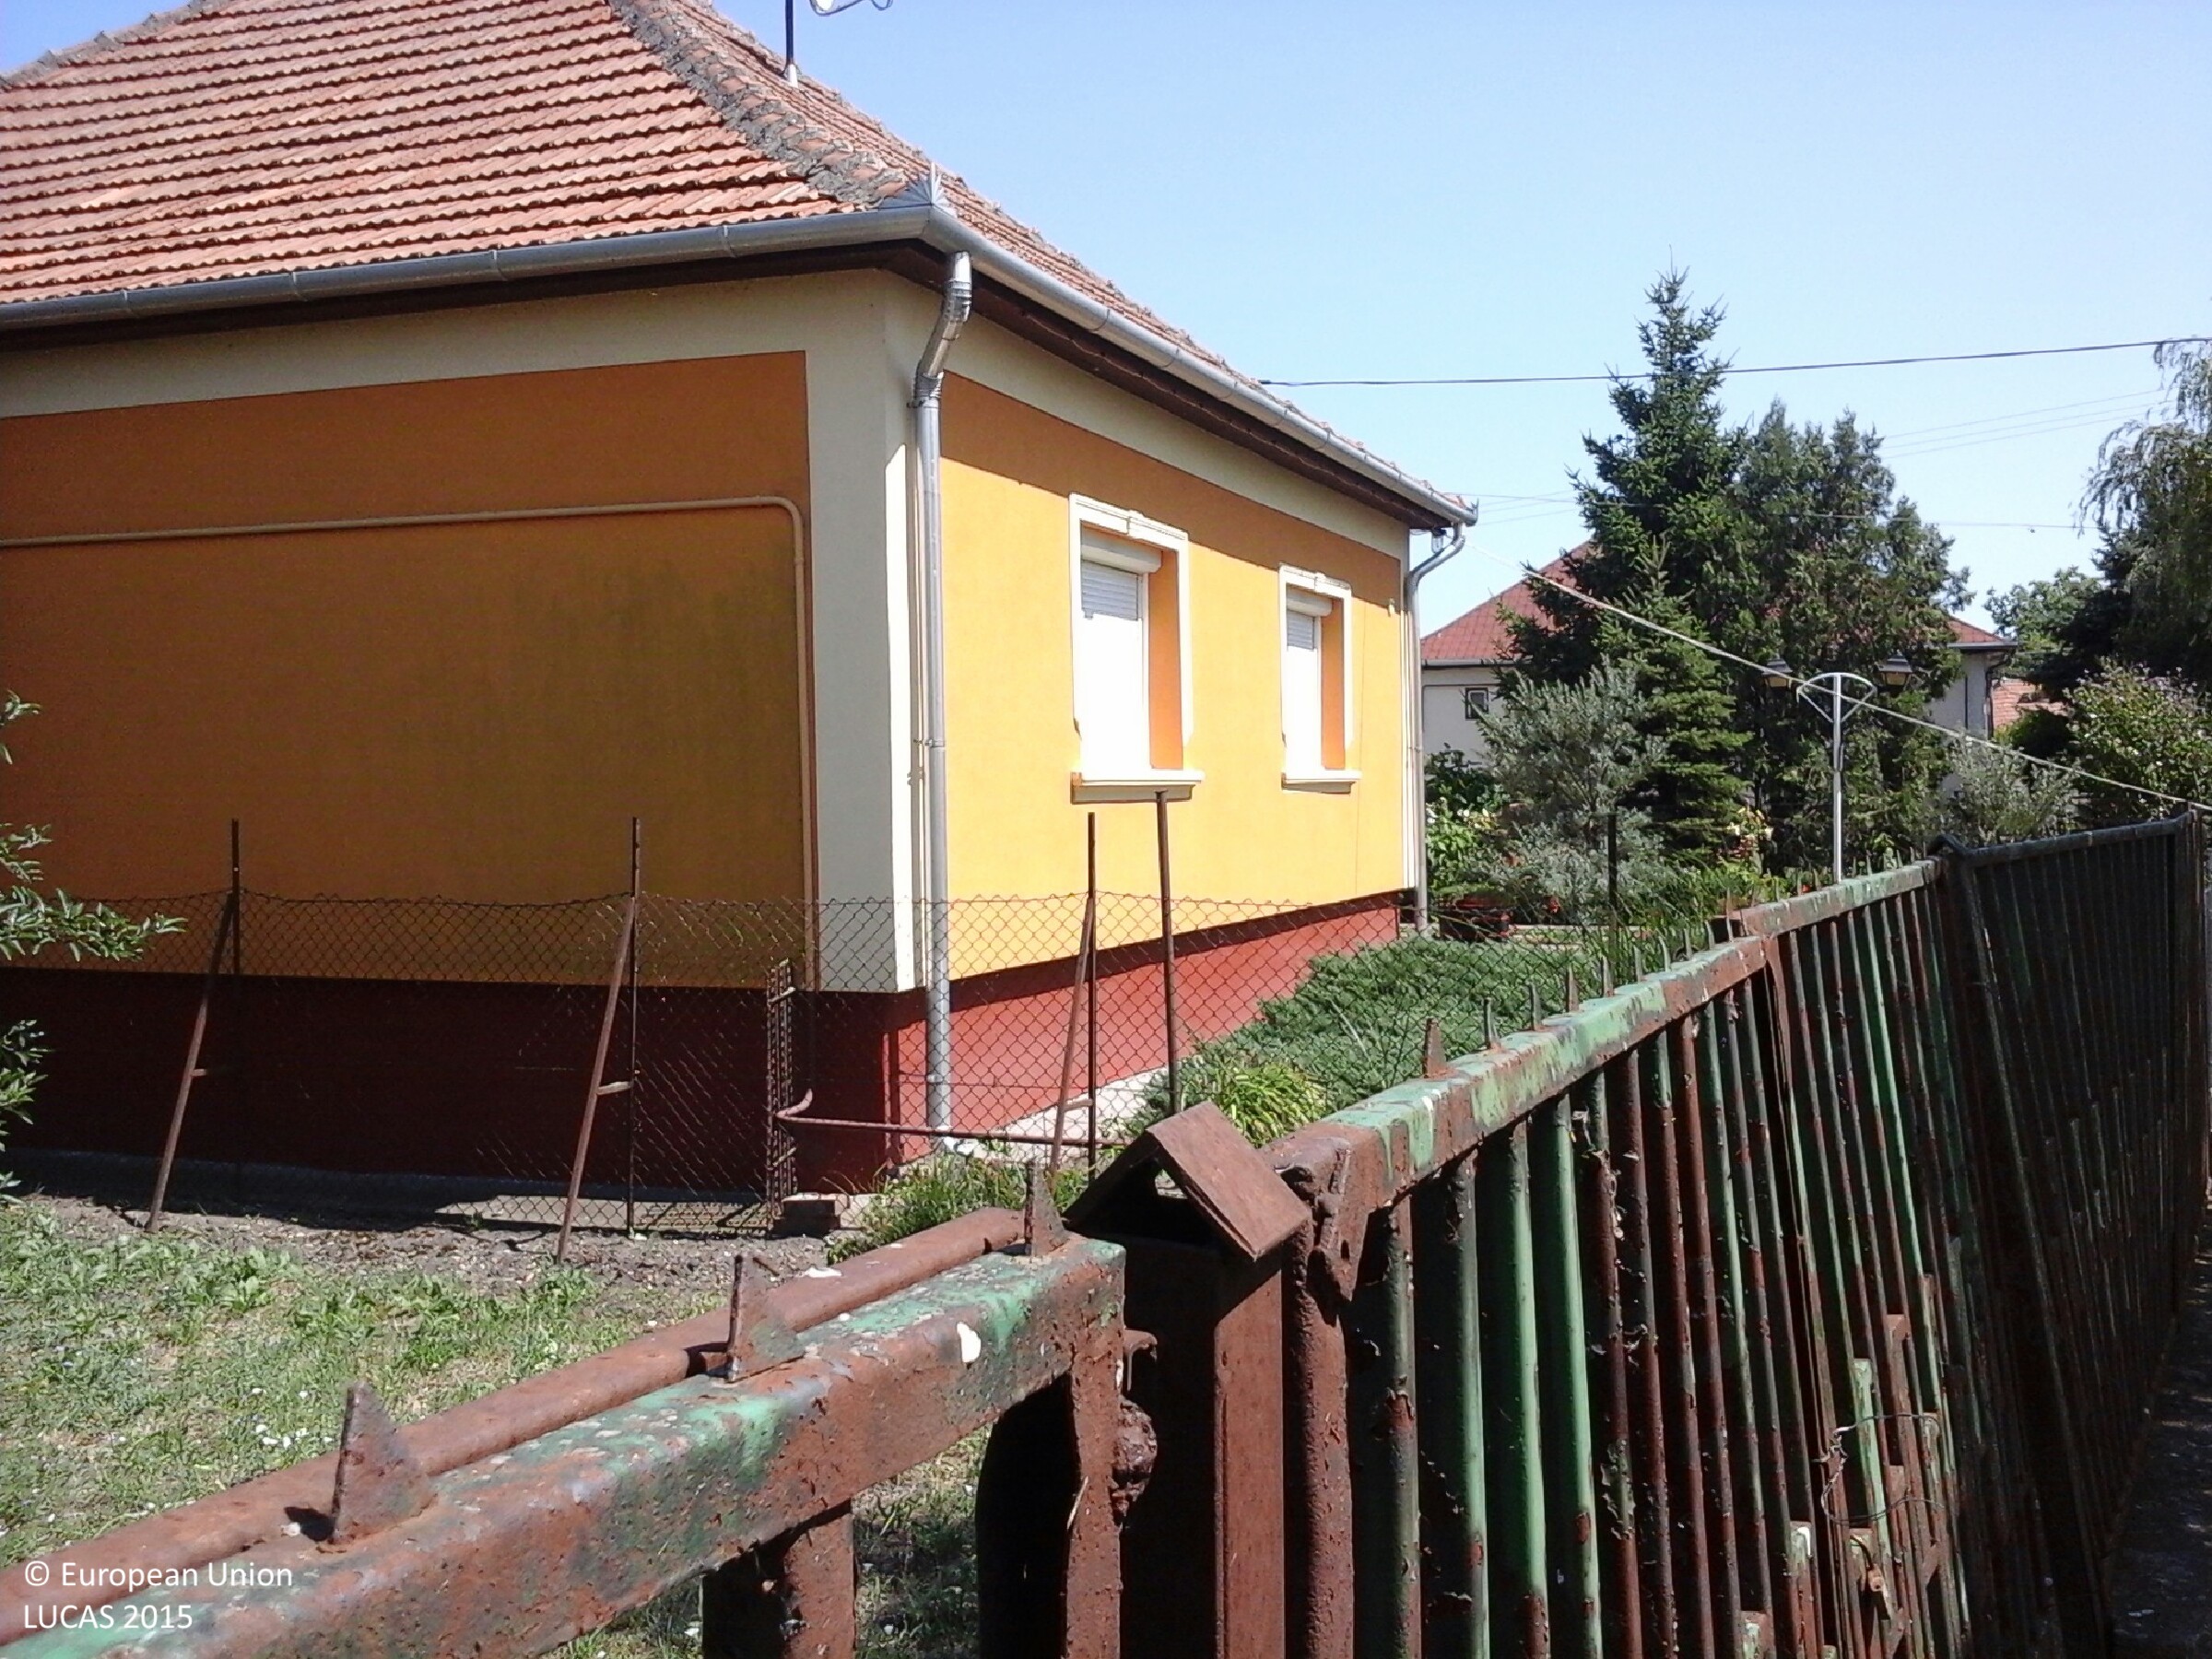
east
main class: Grassland
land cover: Grassland without tree/shrub cover
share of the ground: > 75 %
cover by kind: herbaceous plants 100 %
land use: Residential
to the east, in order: Grassland without tree/shrub cover; Artificial constructions in urban areas; Grassland without tree/shrub cover; Abandoned hedges
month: July
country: HU
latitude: 47.6522
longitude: 20.6442
